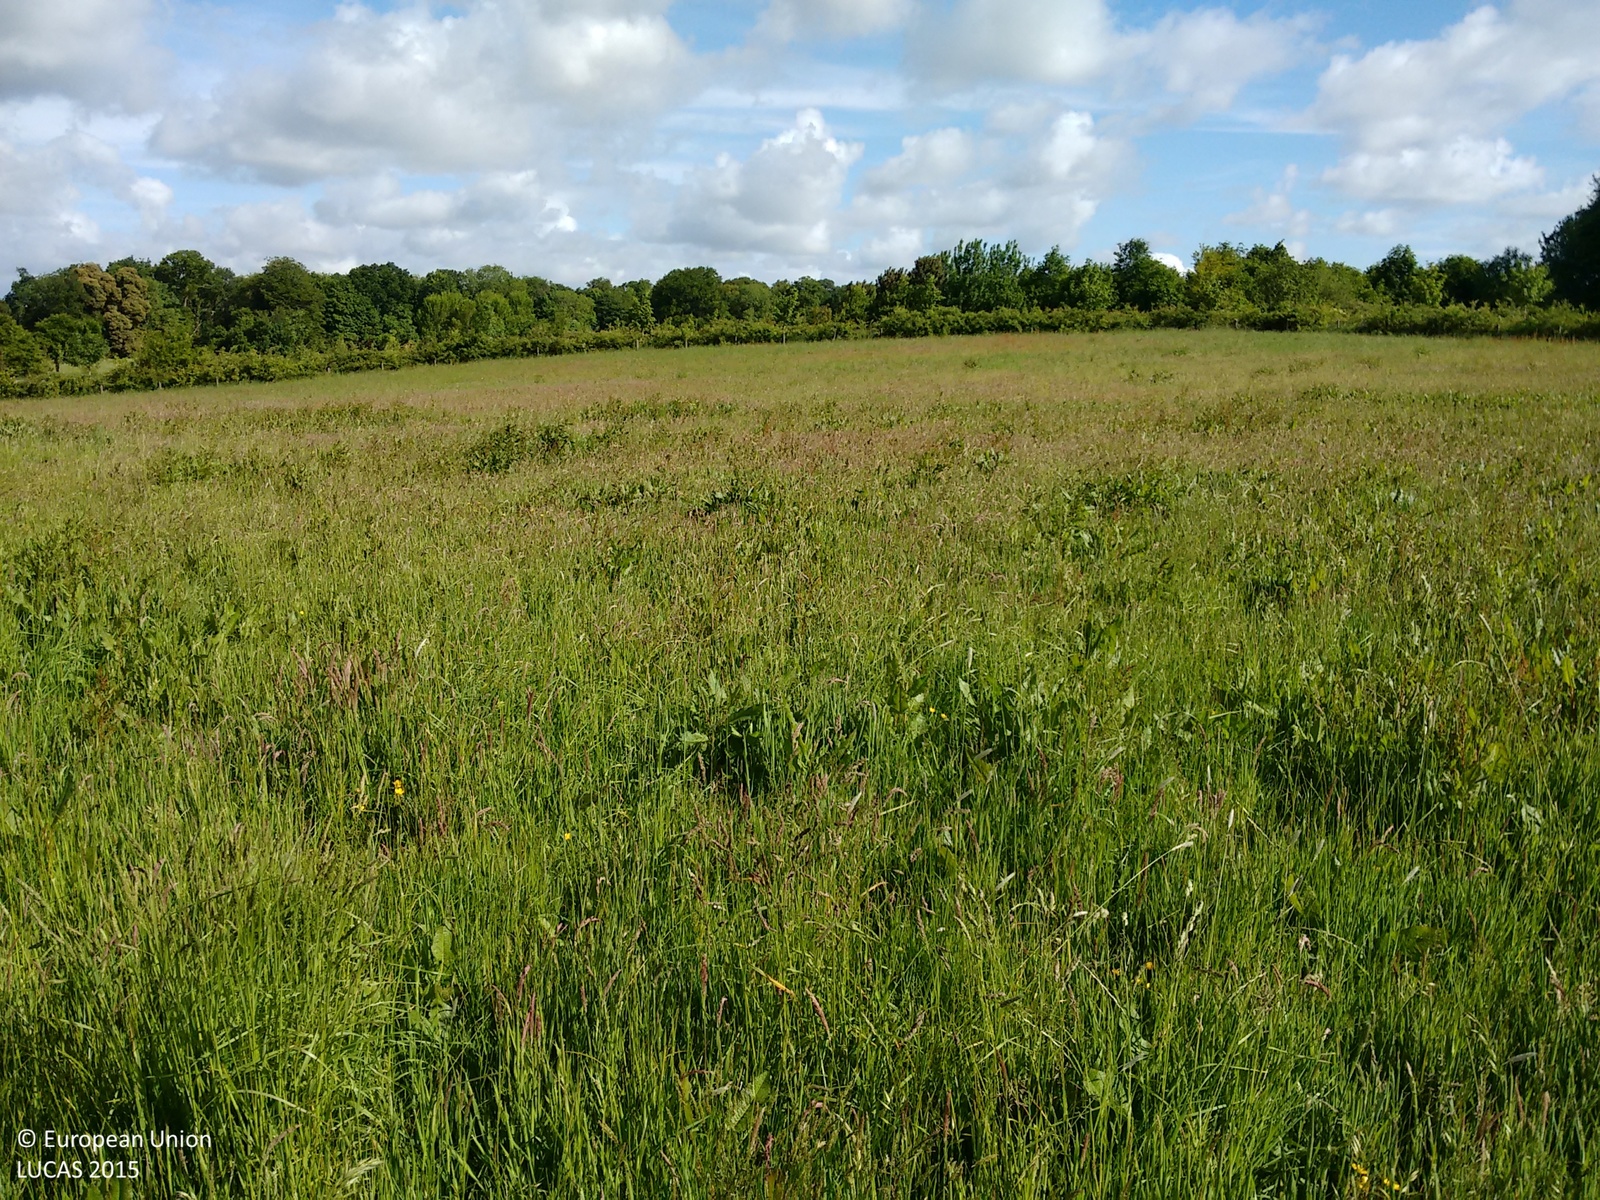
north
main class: Grassland
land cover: Grassland without tree/shrub cover
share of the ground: > 75 %
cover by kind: herbaceous plants 70 %, consolidated bare surface 30 %
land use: Agriculture (excluding fallow land and kitchen gardens)
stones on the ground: < 10 %
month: June
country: IE
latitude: 51.8954
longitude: -8.3083
